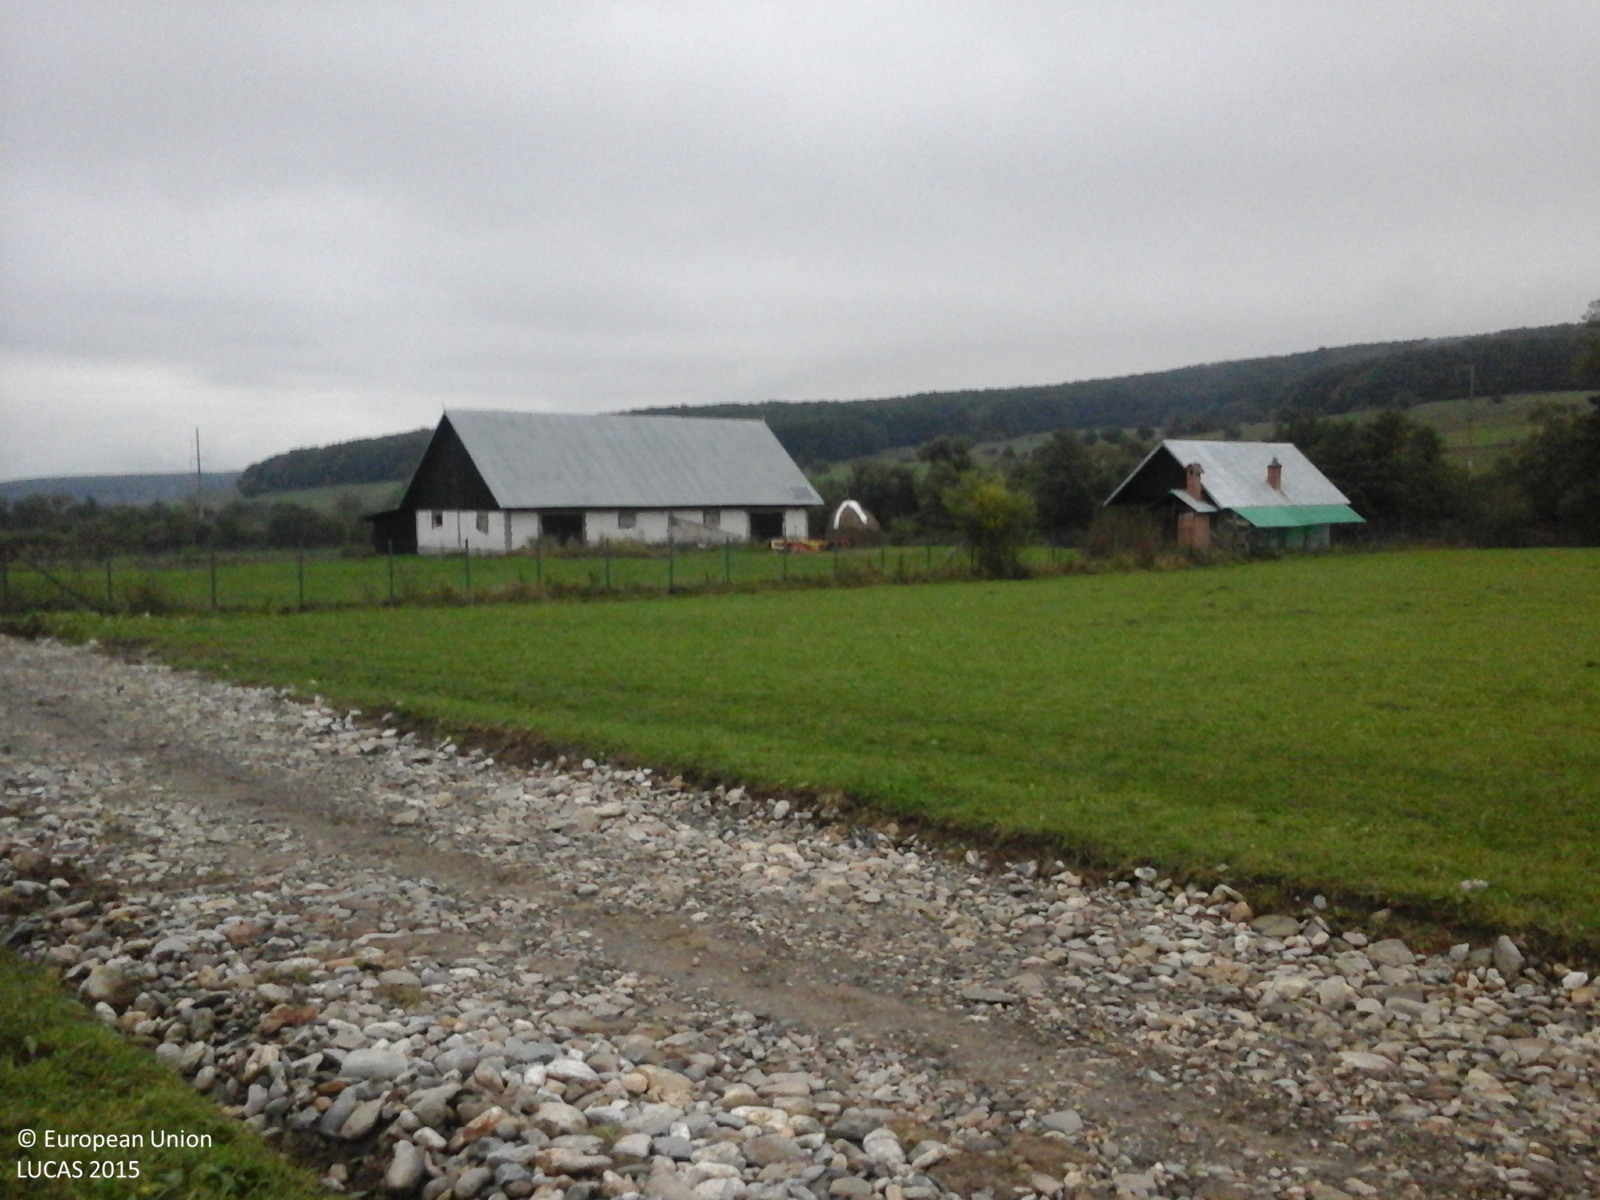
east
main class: Grassland
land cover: Grassland without tree/shrub cover
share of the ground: > 75 %
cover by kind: herbaceous plants 100 %
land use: Agriculture (excluding fallow land and kitchen gardens)
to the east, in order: Grassland without tree/shrub cover; Paved roads, cycling and walking lanes; Grassland without tree/shrub cover; Fences; Grassland without tree/shrub cover; Artificial constructions in urban areas; Grassland without tree/shrub cover; Fences; Grassland without tree/shrub cover; Broadleaved woodland; Rivers and streams; Broadleaved woodland; Grassland without tree/shrub cover
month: October
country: RO
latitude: 45.6955
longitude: 24.1622
